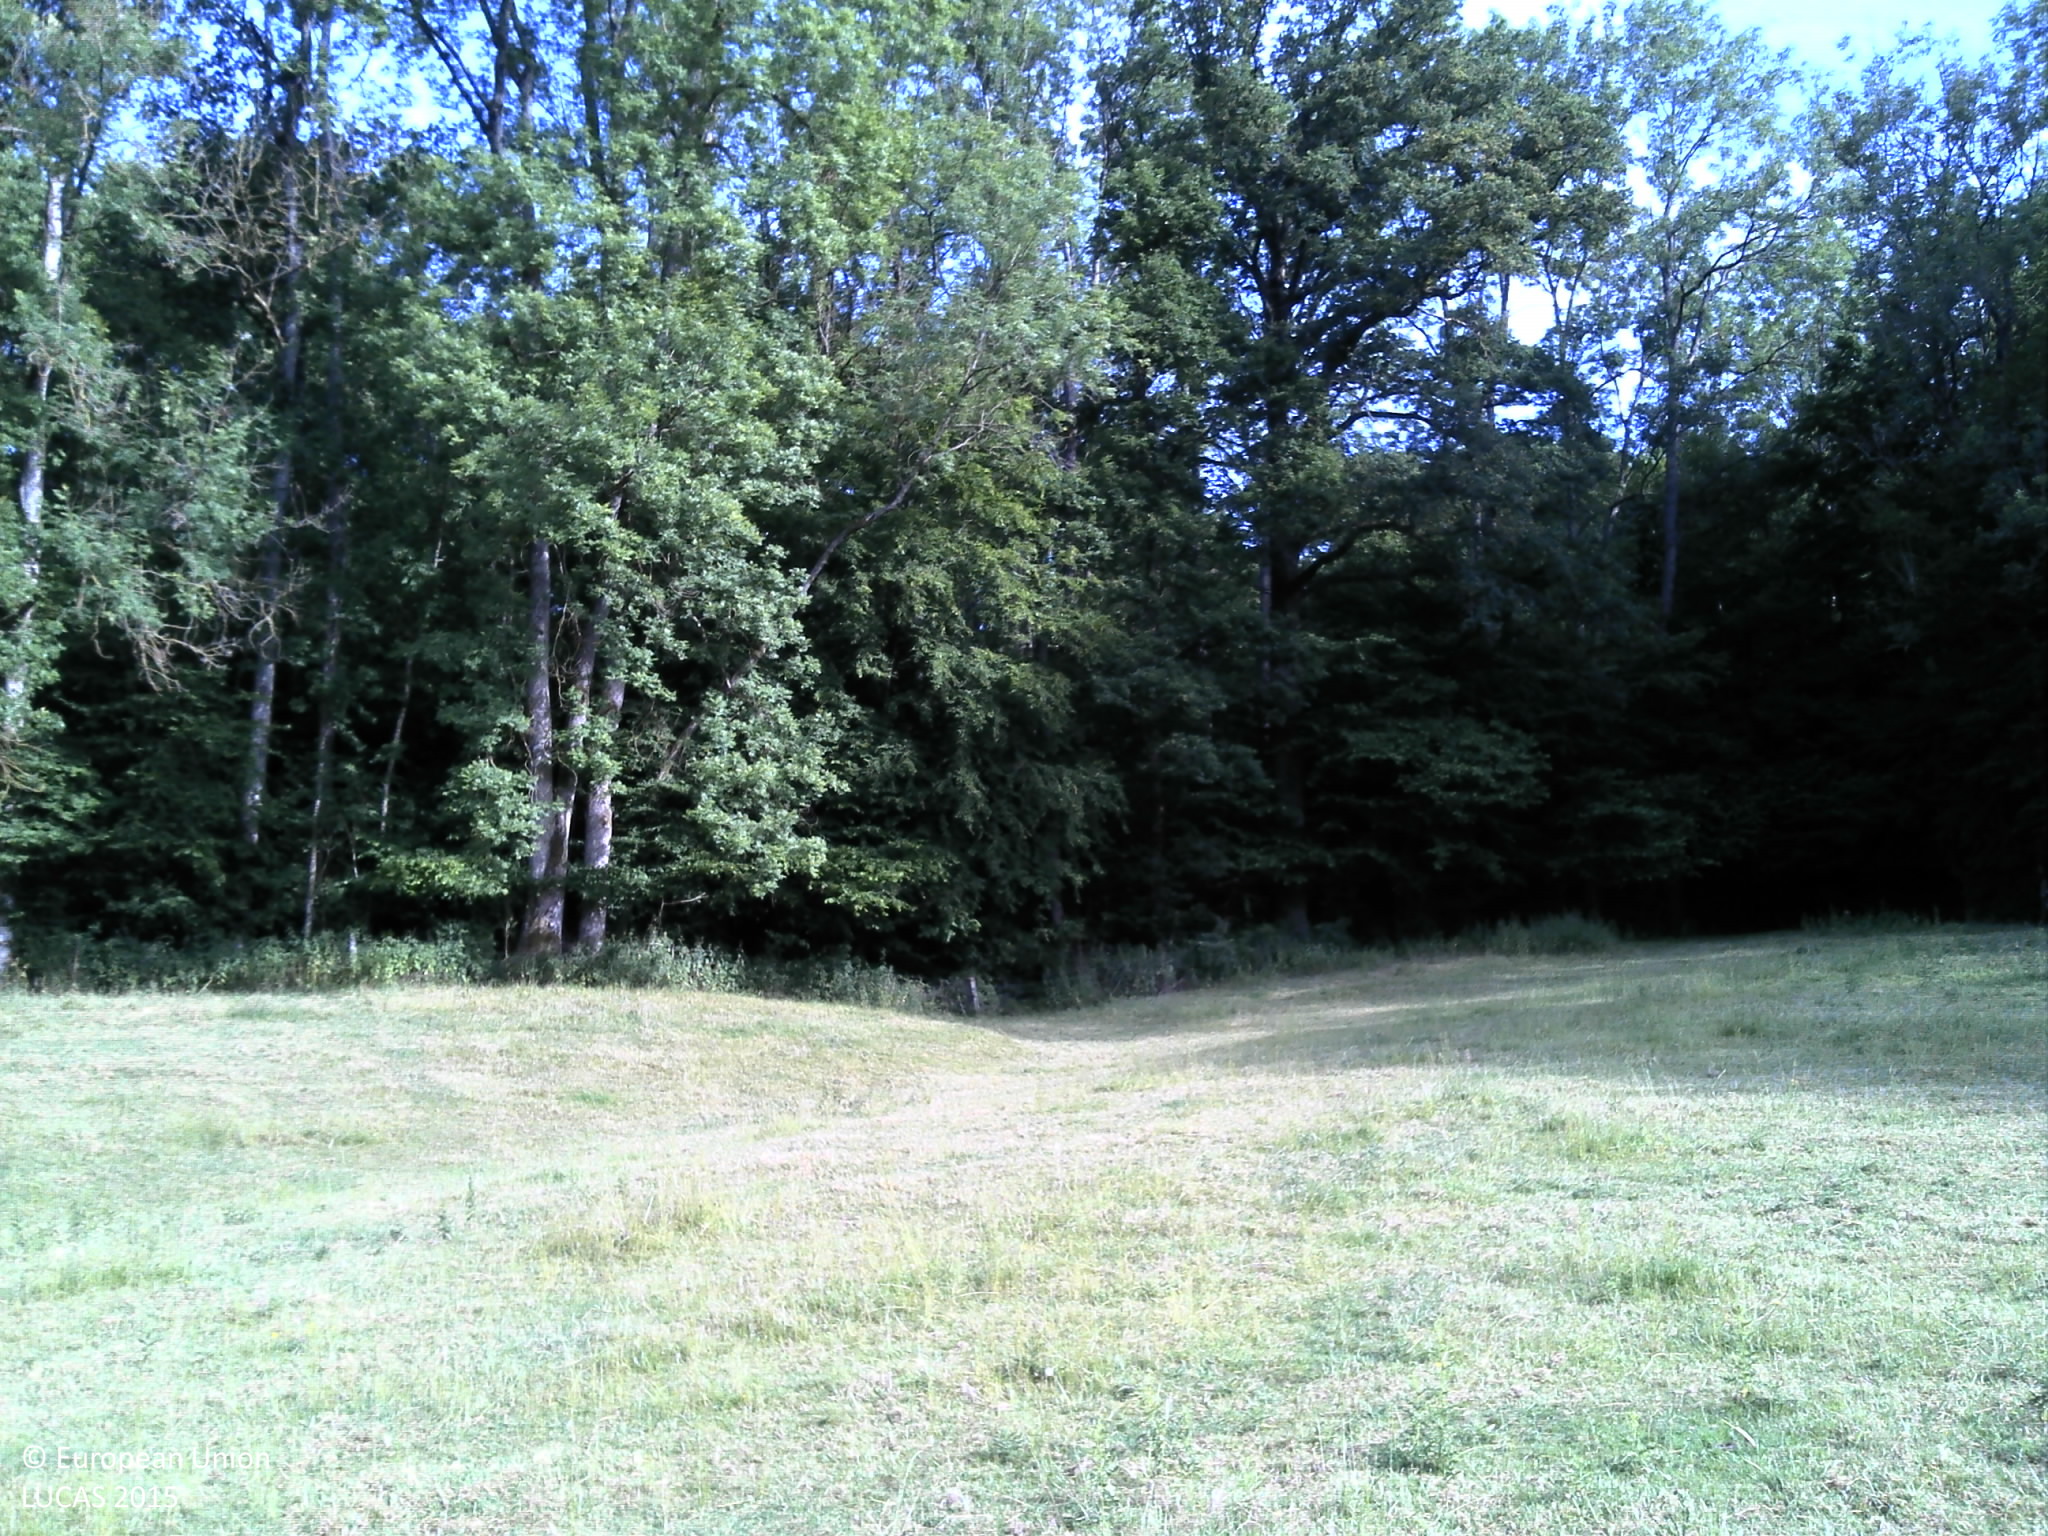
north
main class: Grassland
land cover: Grassland without tree/shrub cover
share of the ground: > 75 %
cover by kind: herbaceous plants 100 %
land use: Agriculture (excluding fallow land and kitchen gardens)
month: June
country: FR
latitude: 49.7064
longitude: 4.8248
